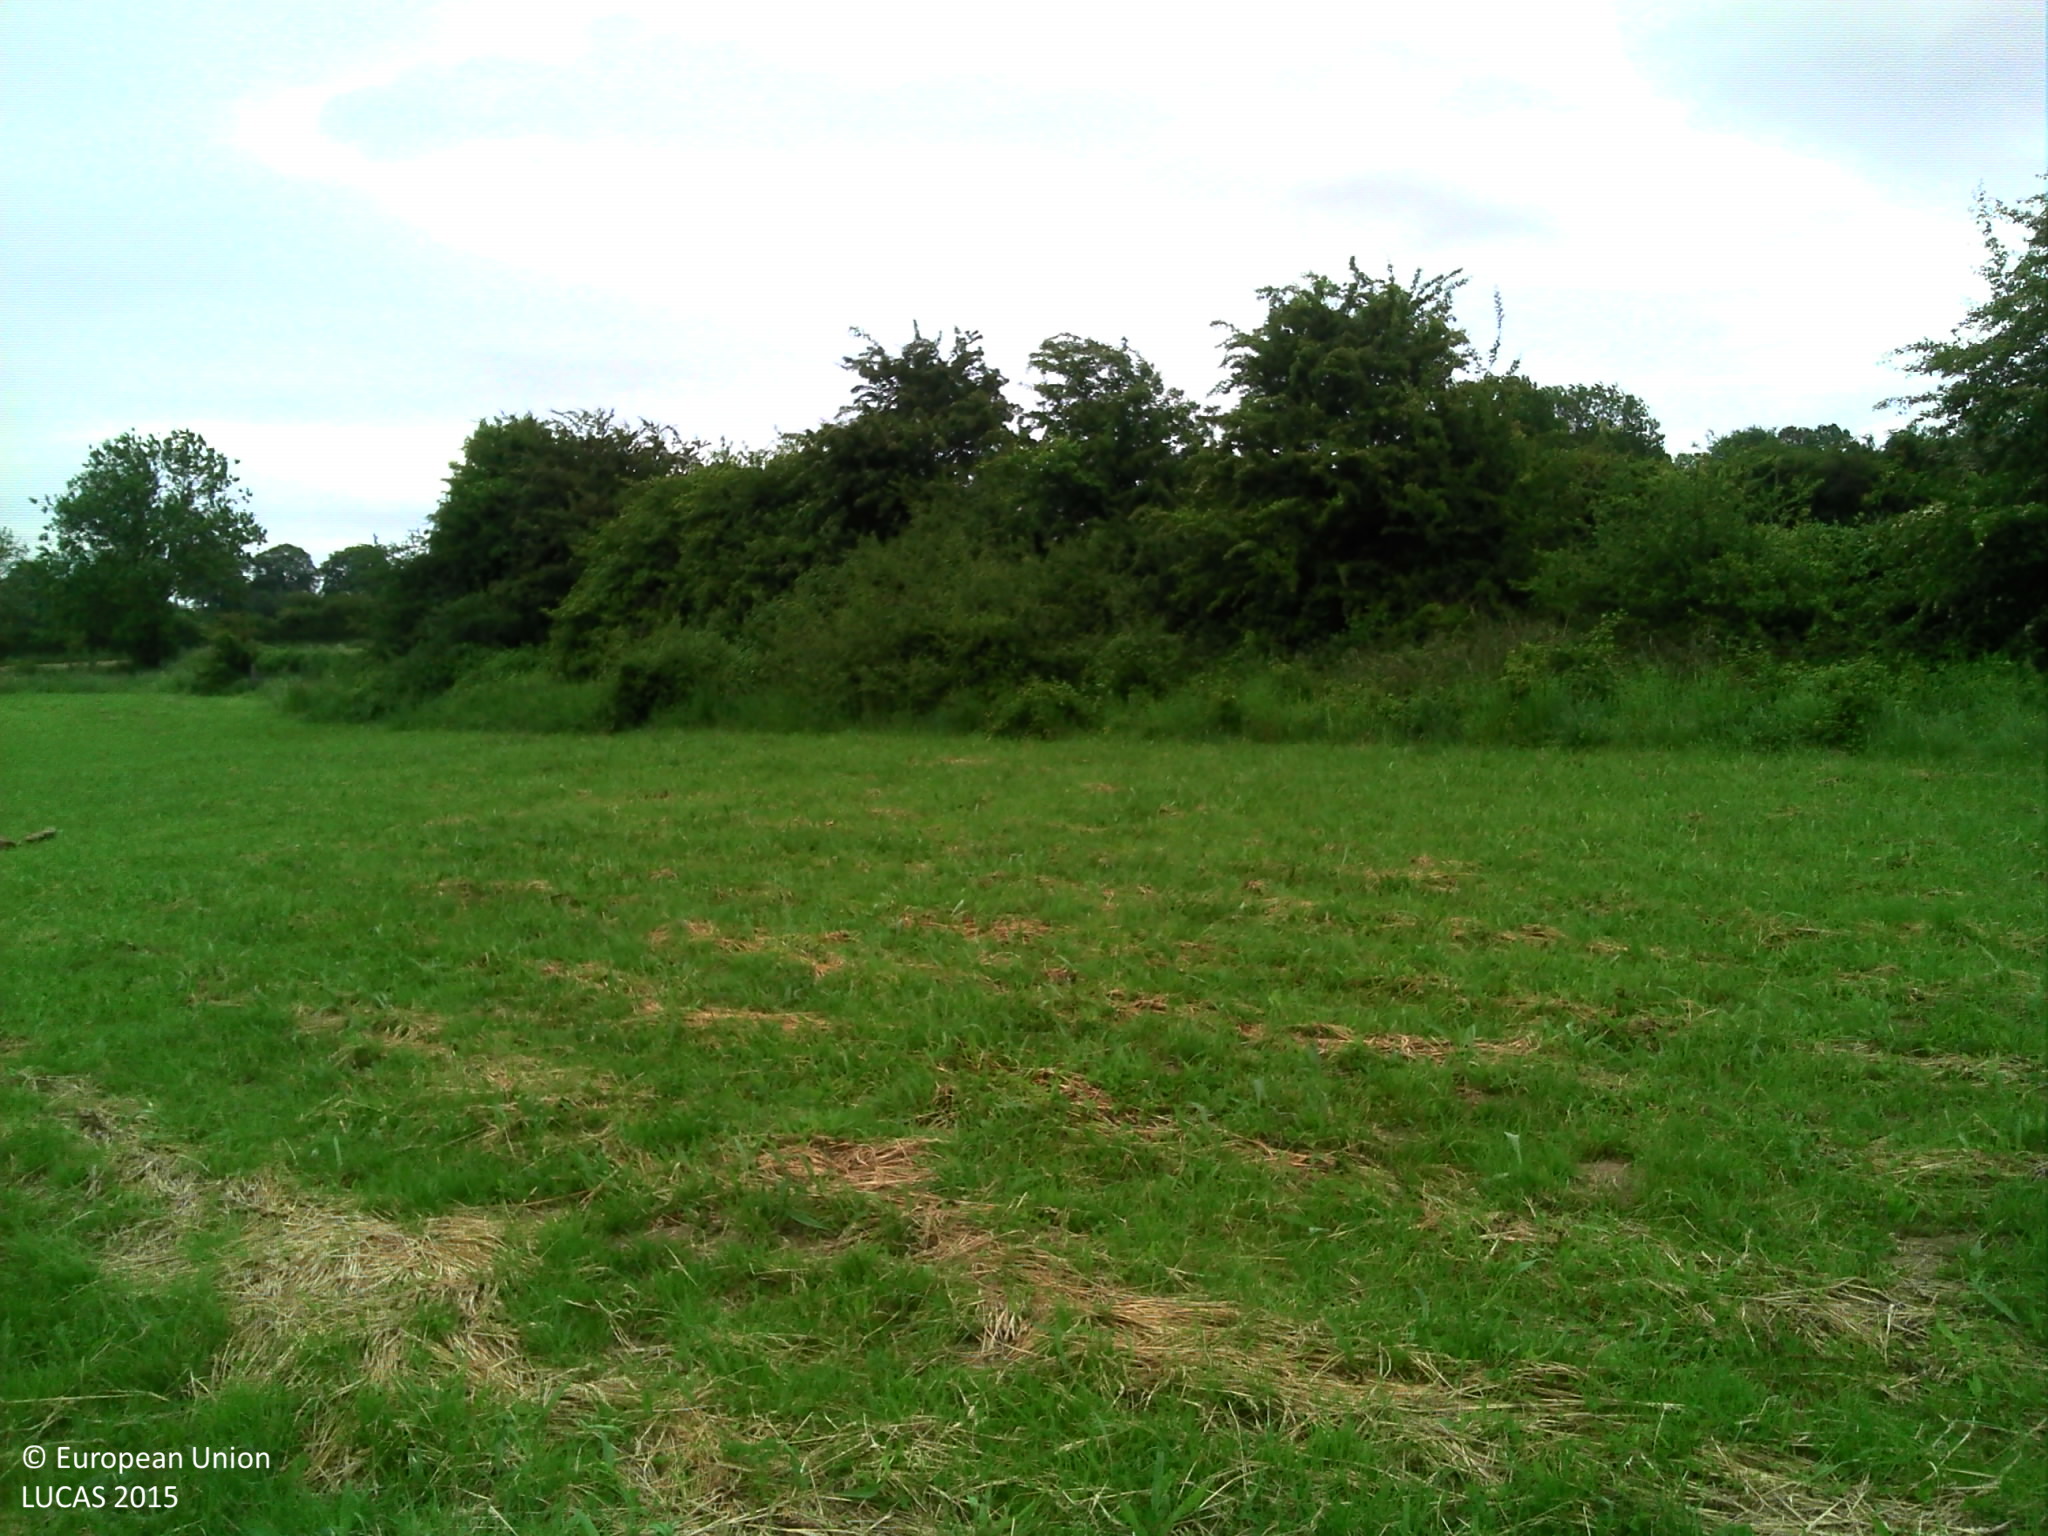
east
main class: Grassland
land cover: Grassland without tree/shrub cover
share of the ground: > 75 %
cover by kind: herbaceous plants 100 %
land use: Agriculture (excluding fallow land and kitchen gardens)
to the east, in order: Grassland without tree/shrub cover; Abandoned hedges; Grass margins; Tracks; Grass margins; Managed hedges; Other bare soil; Grass margins; Abandoned hedges; Grassland without tree/shrub cover; Fences; Grass margins; Tracks; Grass margins; Broadleaved woodland; Shrubland without tree cover; Mixed cereals for fodder
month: June
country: BE
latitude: 50.4222
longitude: 5.5647
